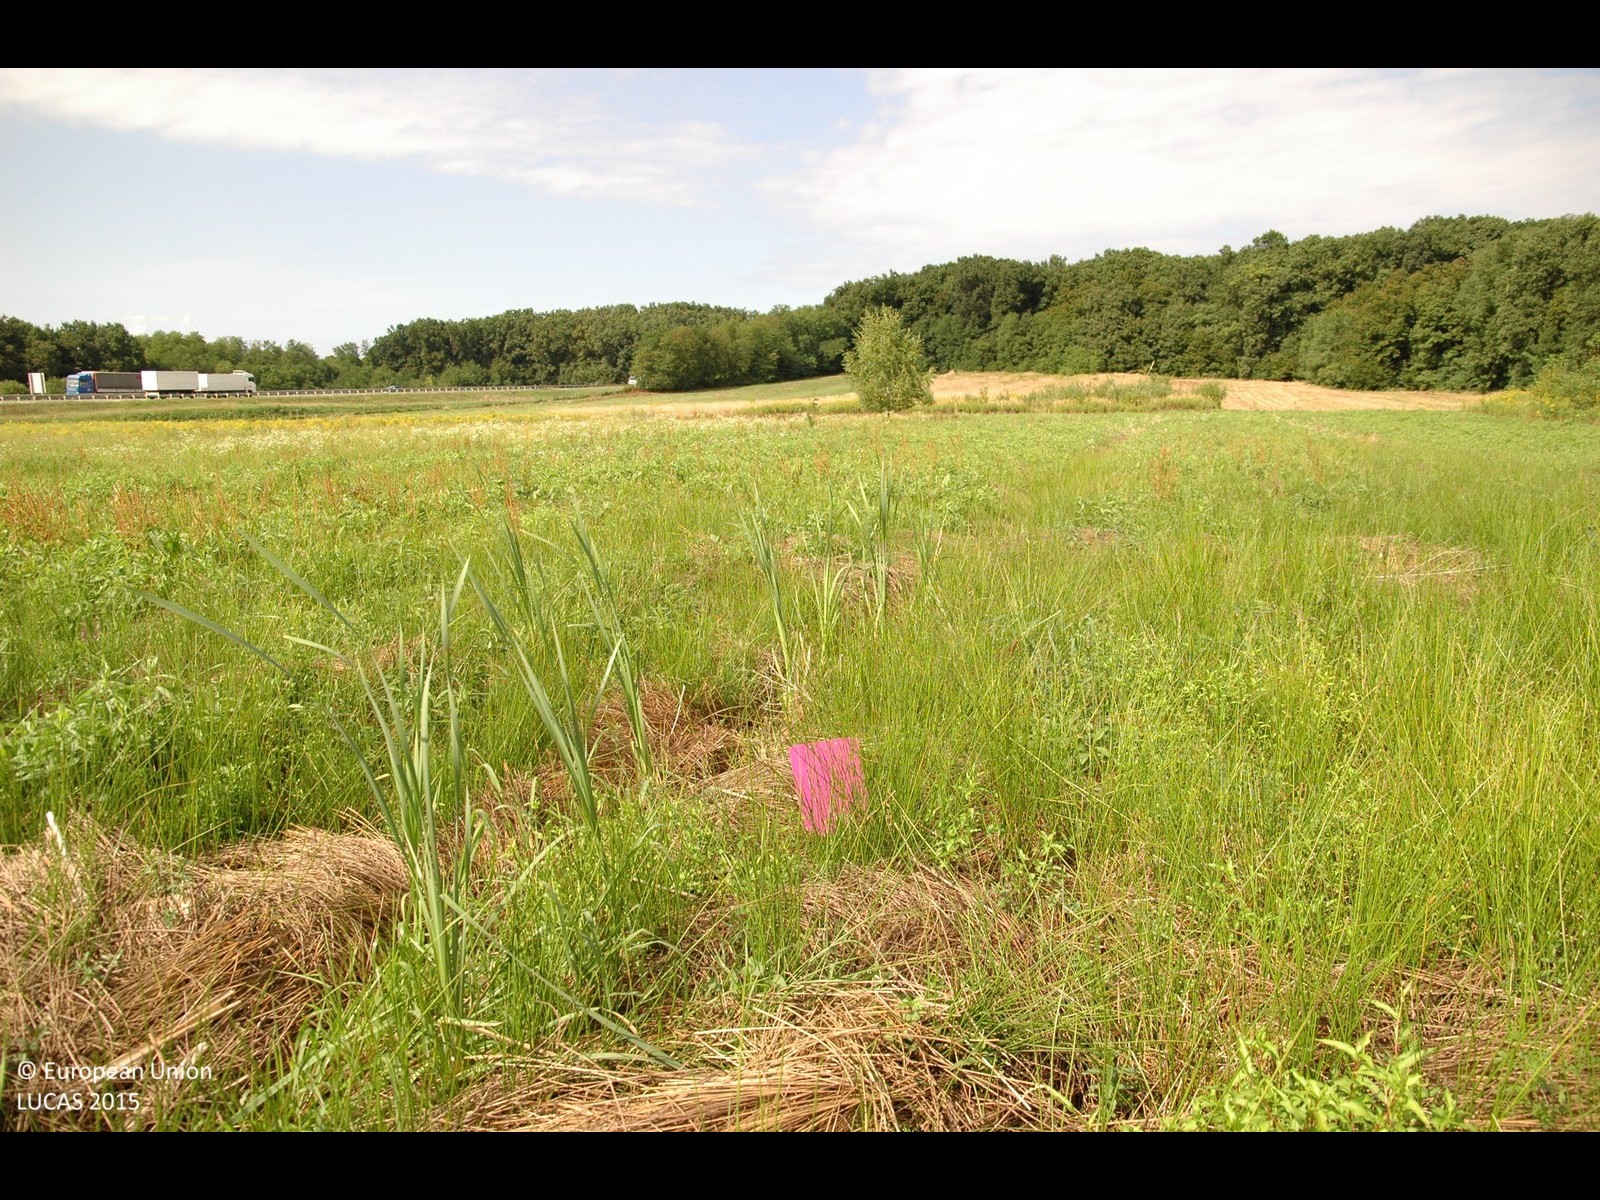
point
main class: Grassland
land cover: Grassland without tree/shrub cover
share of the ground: > 75 %
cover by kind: herbaceous plants 100 %
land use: Agriculture (excluding fallow land and kitchen gardens)
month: August
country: HR
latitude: 45.8317
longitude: 16.1389
